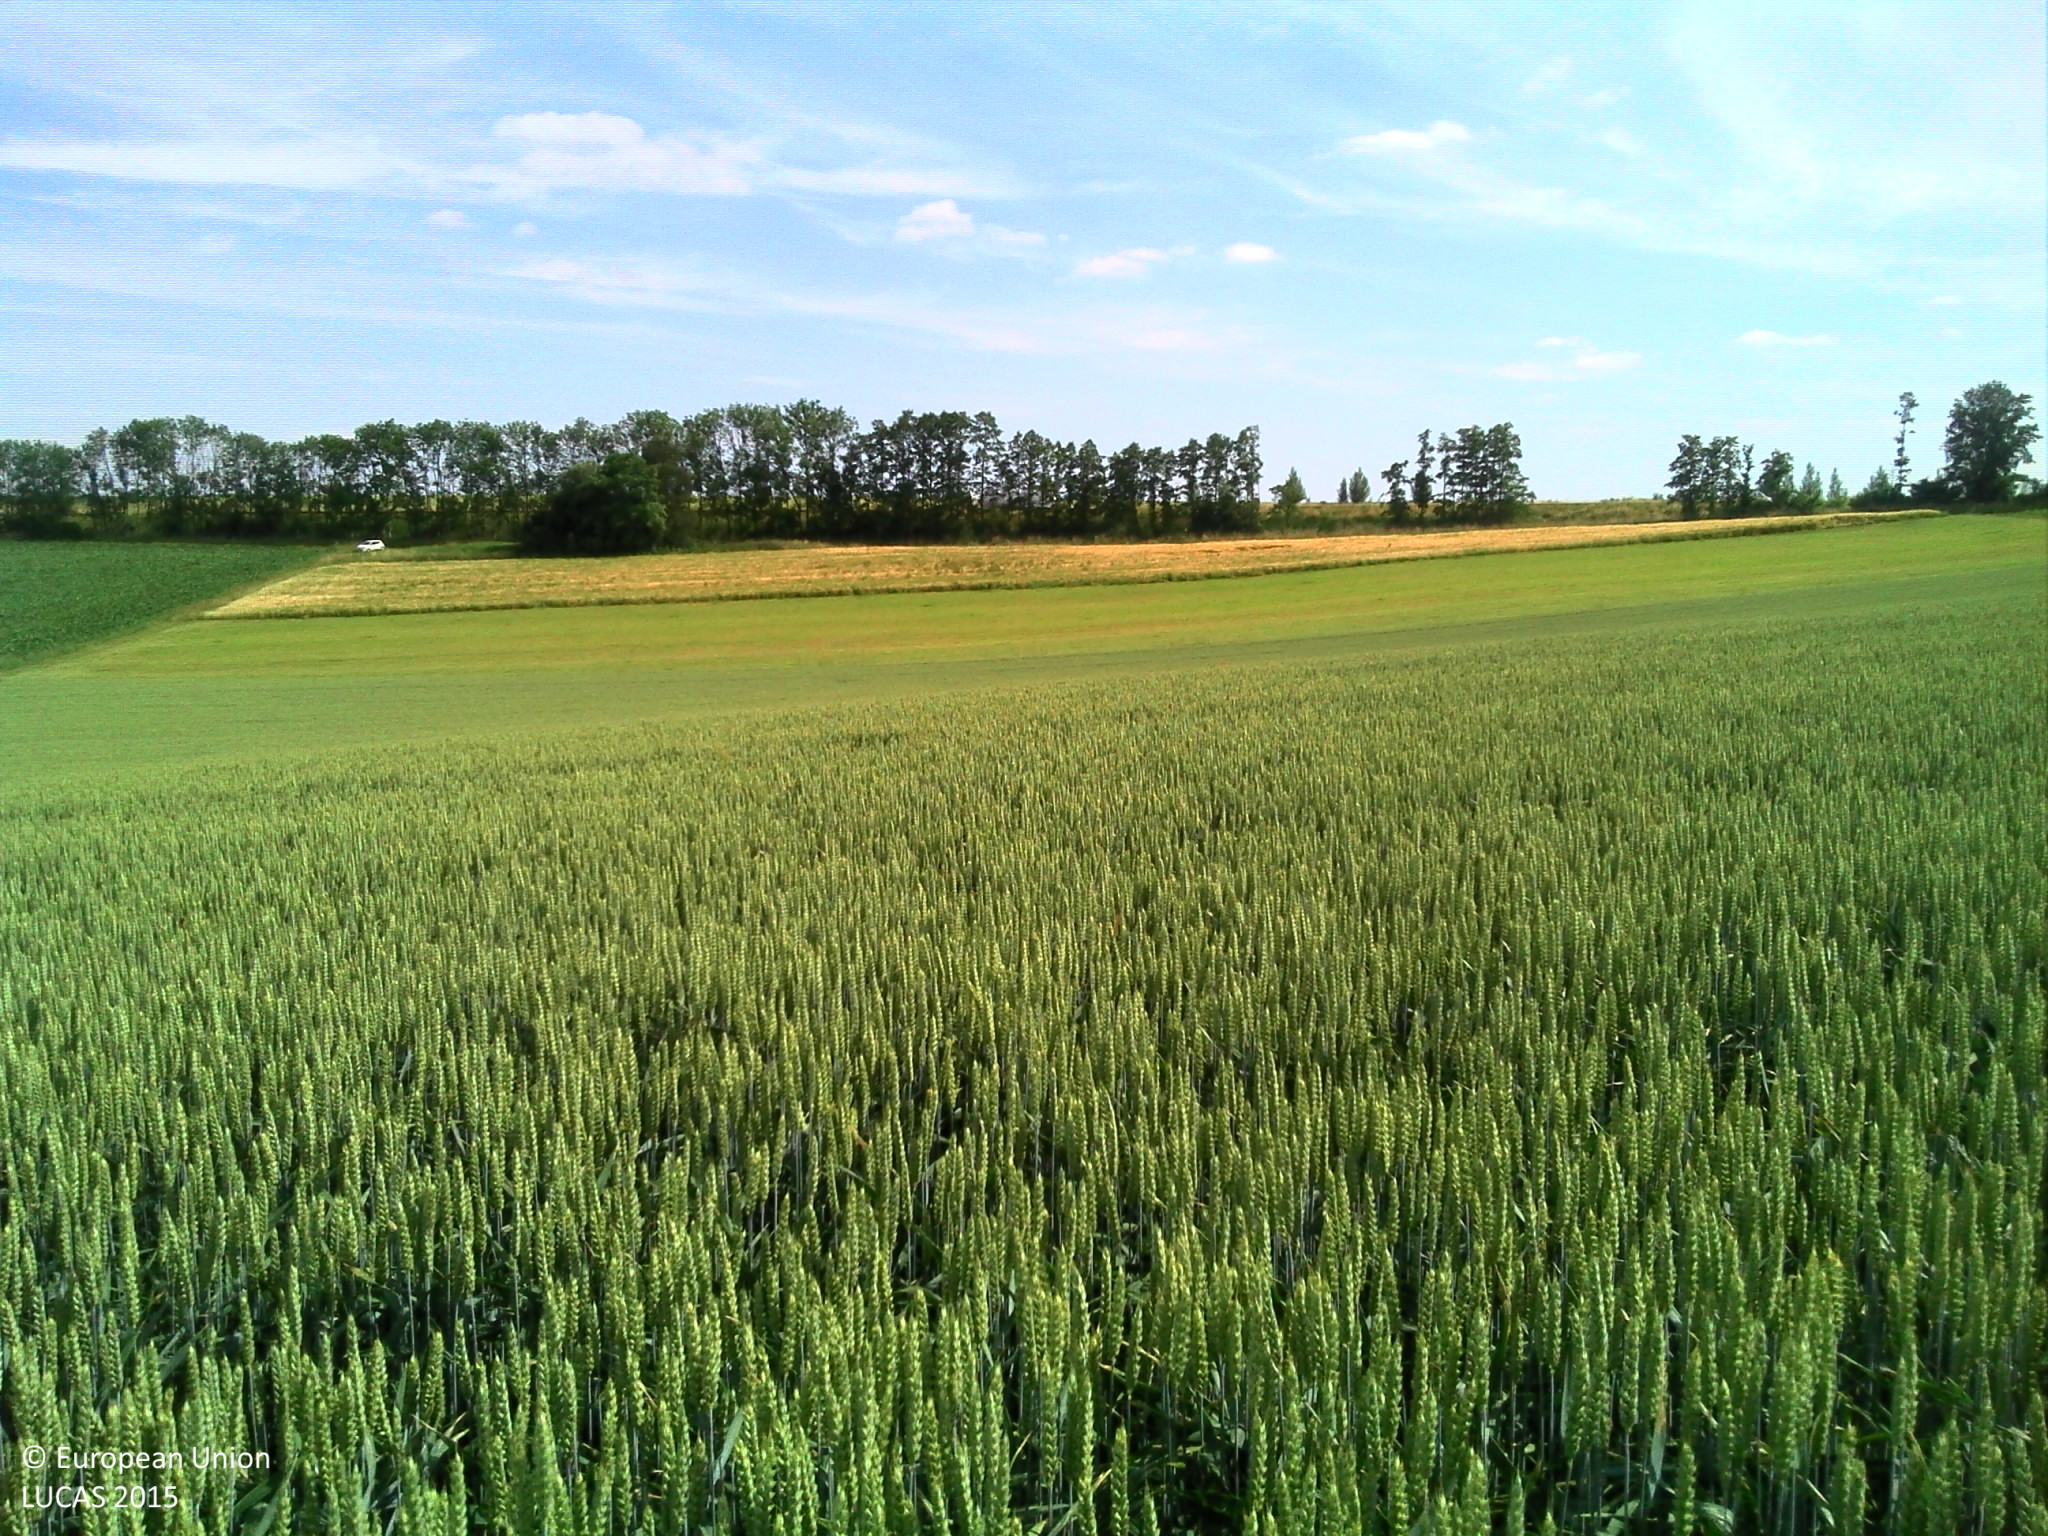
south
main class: Cropland
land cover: Common wheat
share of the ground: > 75 %
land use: Agriculture (excluding fallow land and kitchen gardens)
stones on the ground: < 10 %
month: June
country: FR
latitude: 48.7721
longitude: 7.5379
